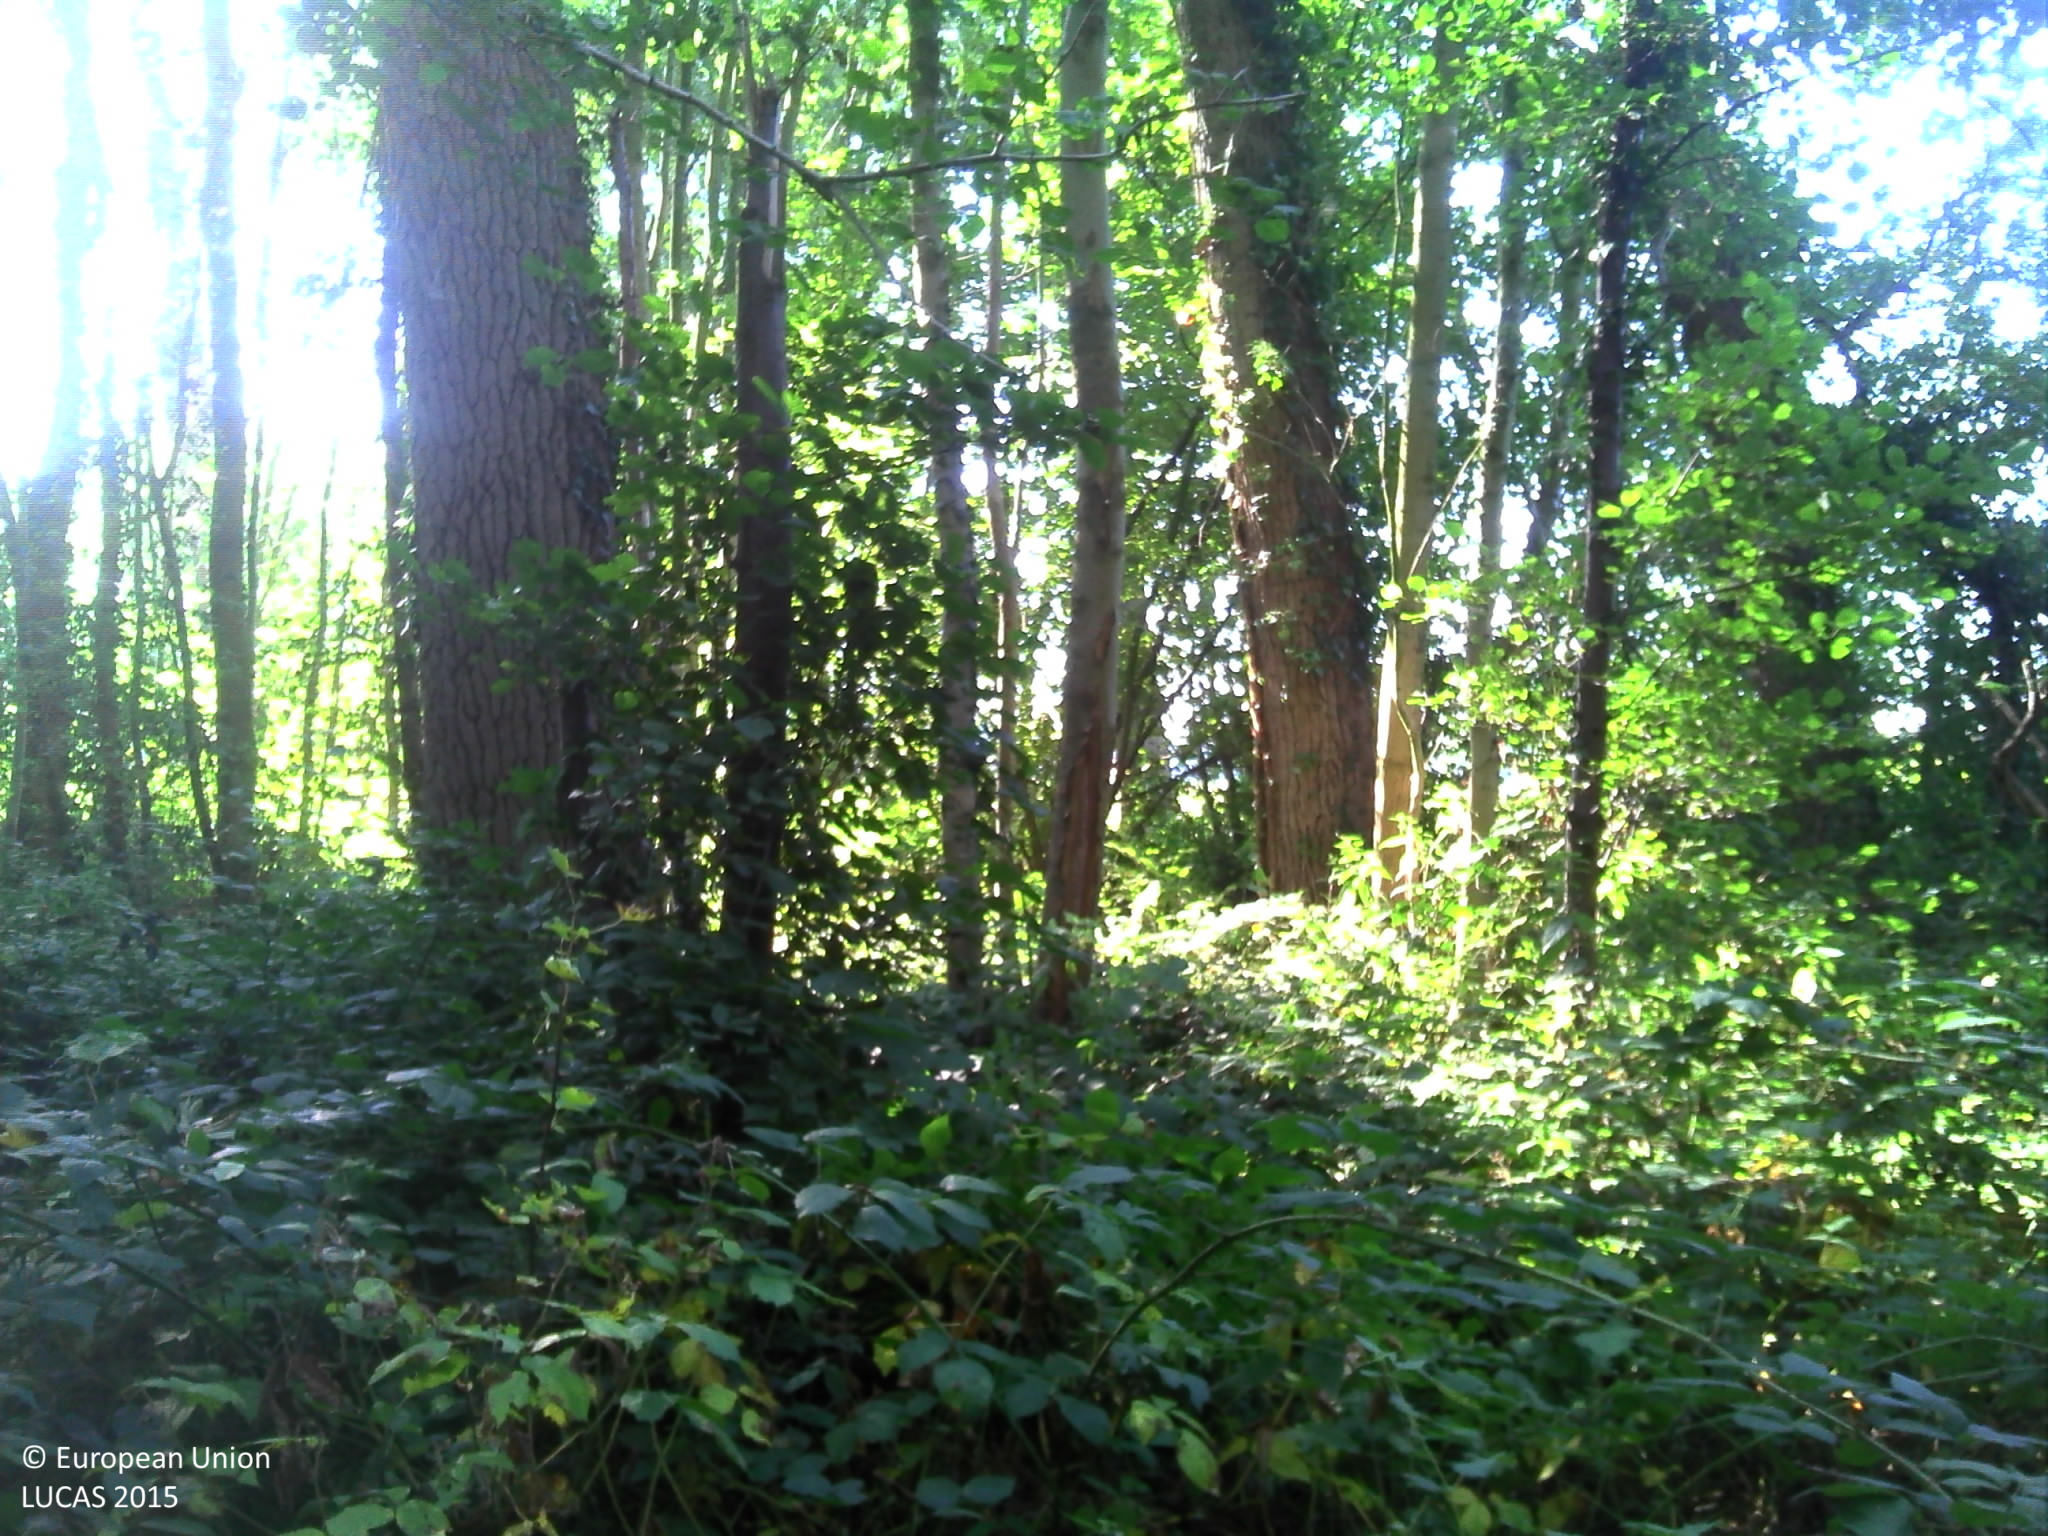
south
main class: Woodland
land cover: Broadleaved woodland
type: non-riverine alder, birch or aspen forest
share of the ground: > 75 %
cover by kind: broadleaved forest trees 95 %, herbaceous plants 5 %
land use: Forestry
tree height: > 5 m
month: September
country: BE
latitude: 51.2162
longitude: 4.7423
